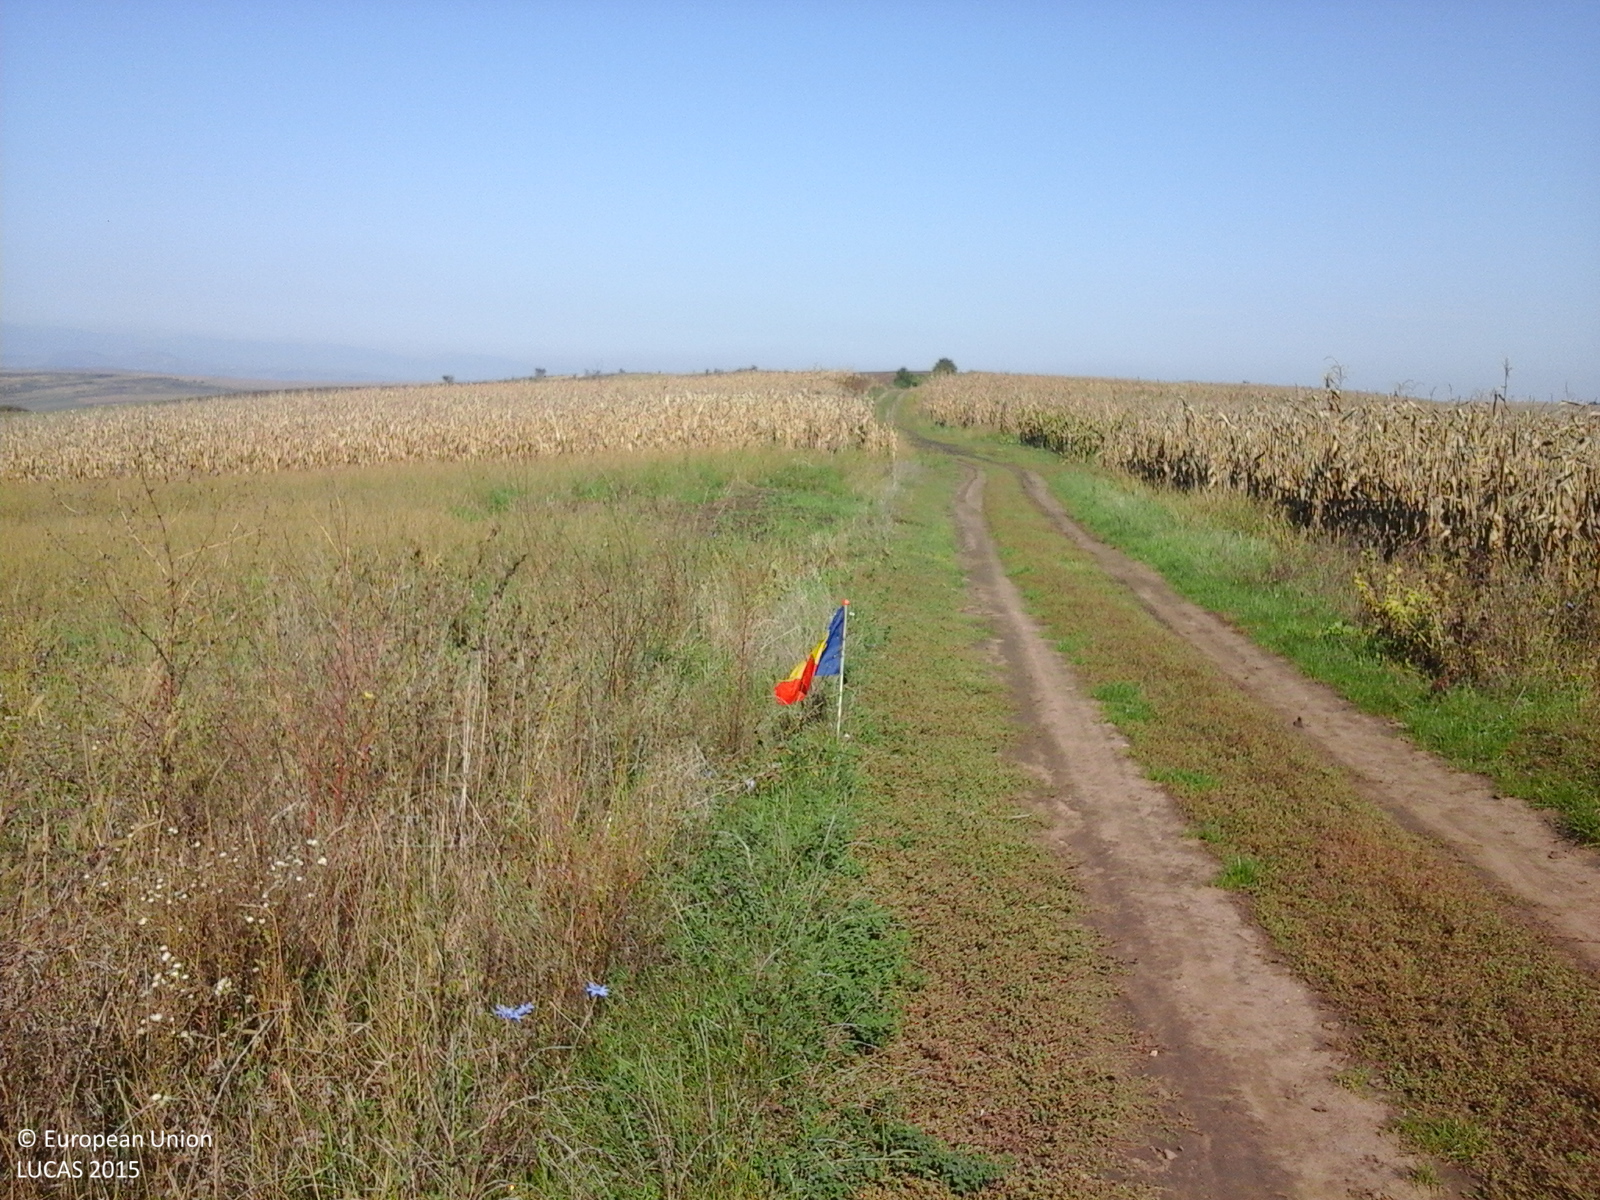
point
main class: Cropland
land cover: Maize
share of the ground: > 75 %
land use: Agriculture (excluding fallow land and kitchen gardens)
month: October
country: RO
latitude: 46.0993
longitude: 23.8741
